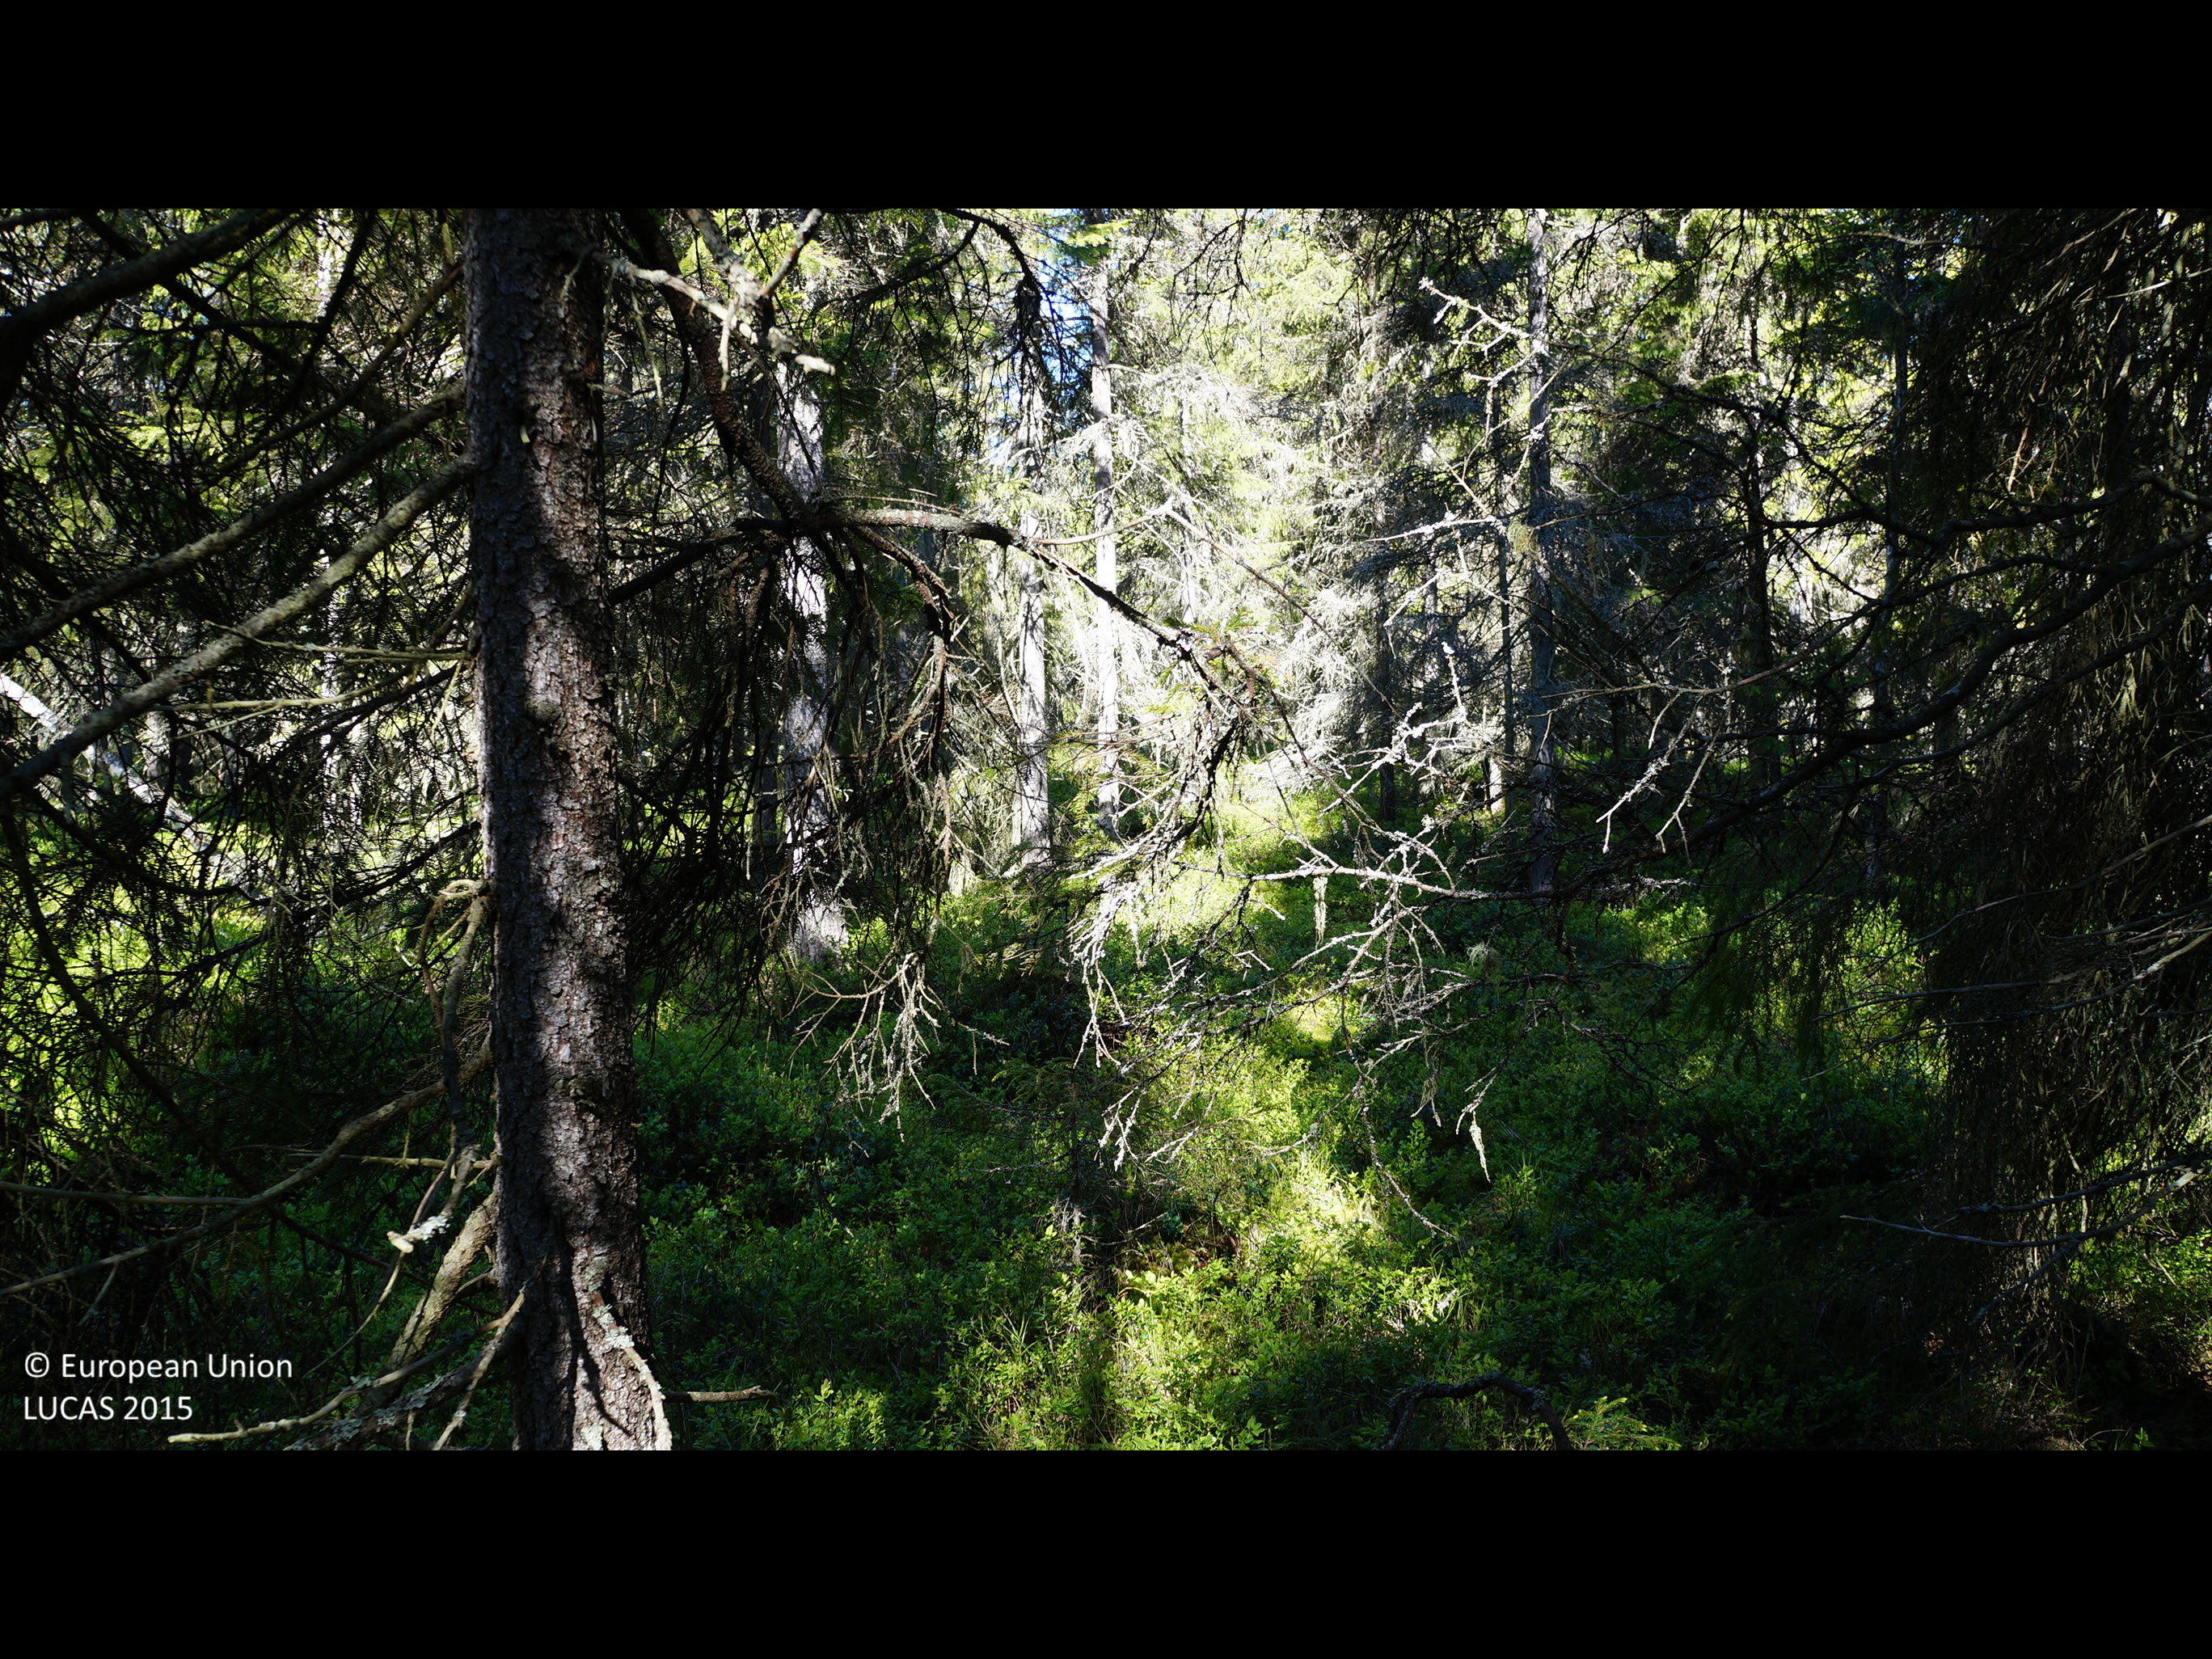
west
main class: Woodland
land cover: Spruce dominated coniferous woodland
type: boreal forest
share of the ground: > 75 %
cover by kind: coniferous forest trees 90 %, shrubs 5 %, herbaceous plants 5 %
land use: Forestry
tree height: > 5 m
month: June
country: FI
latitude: 64.3447
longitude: 23.9935
